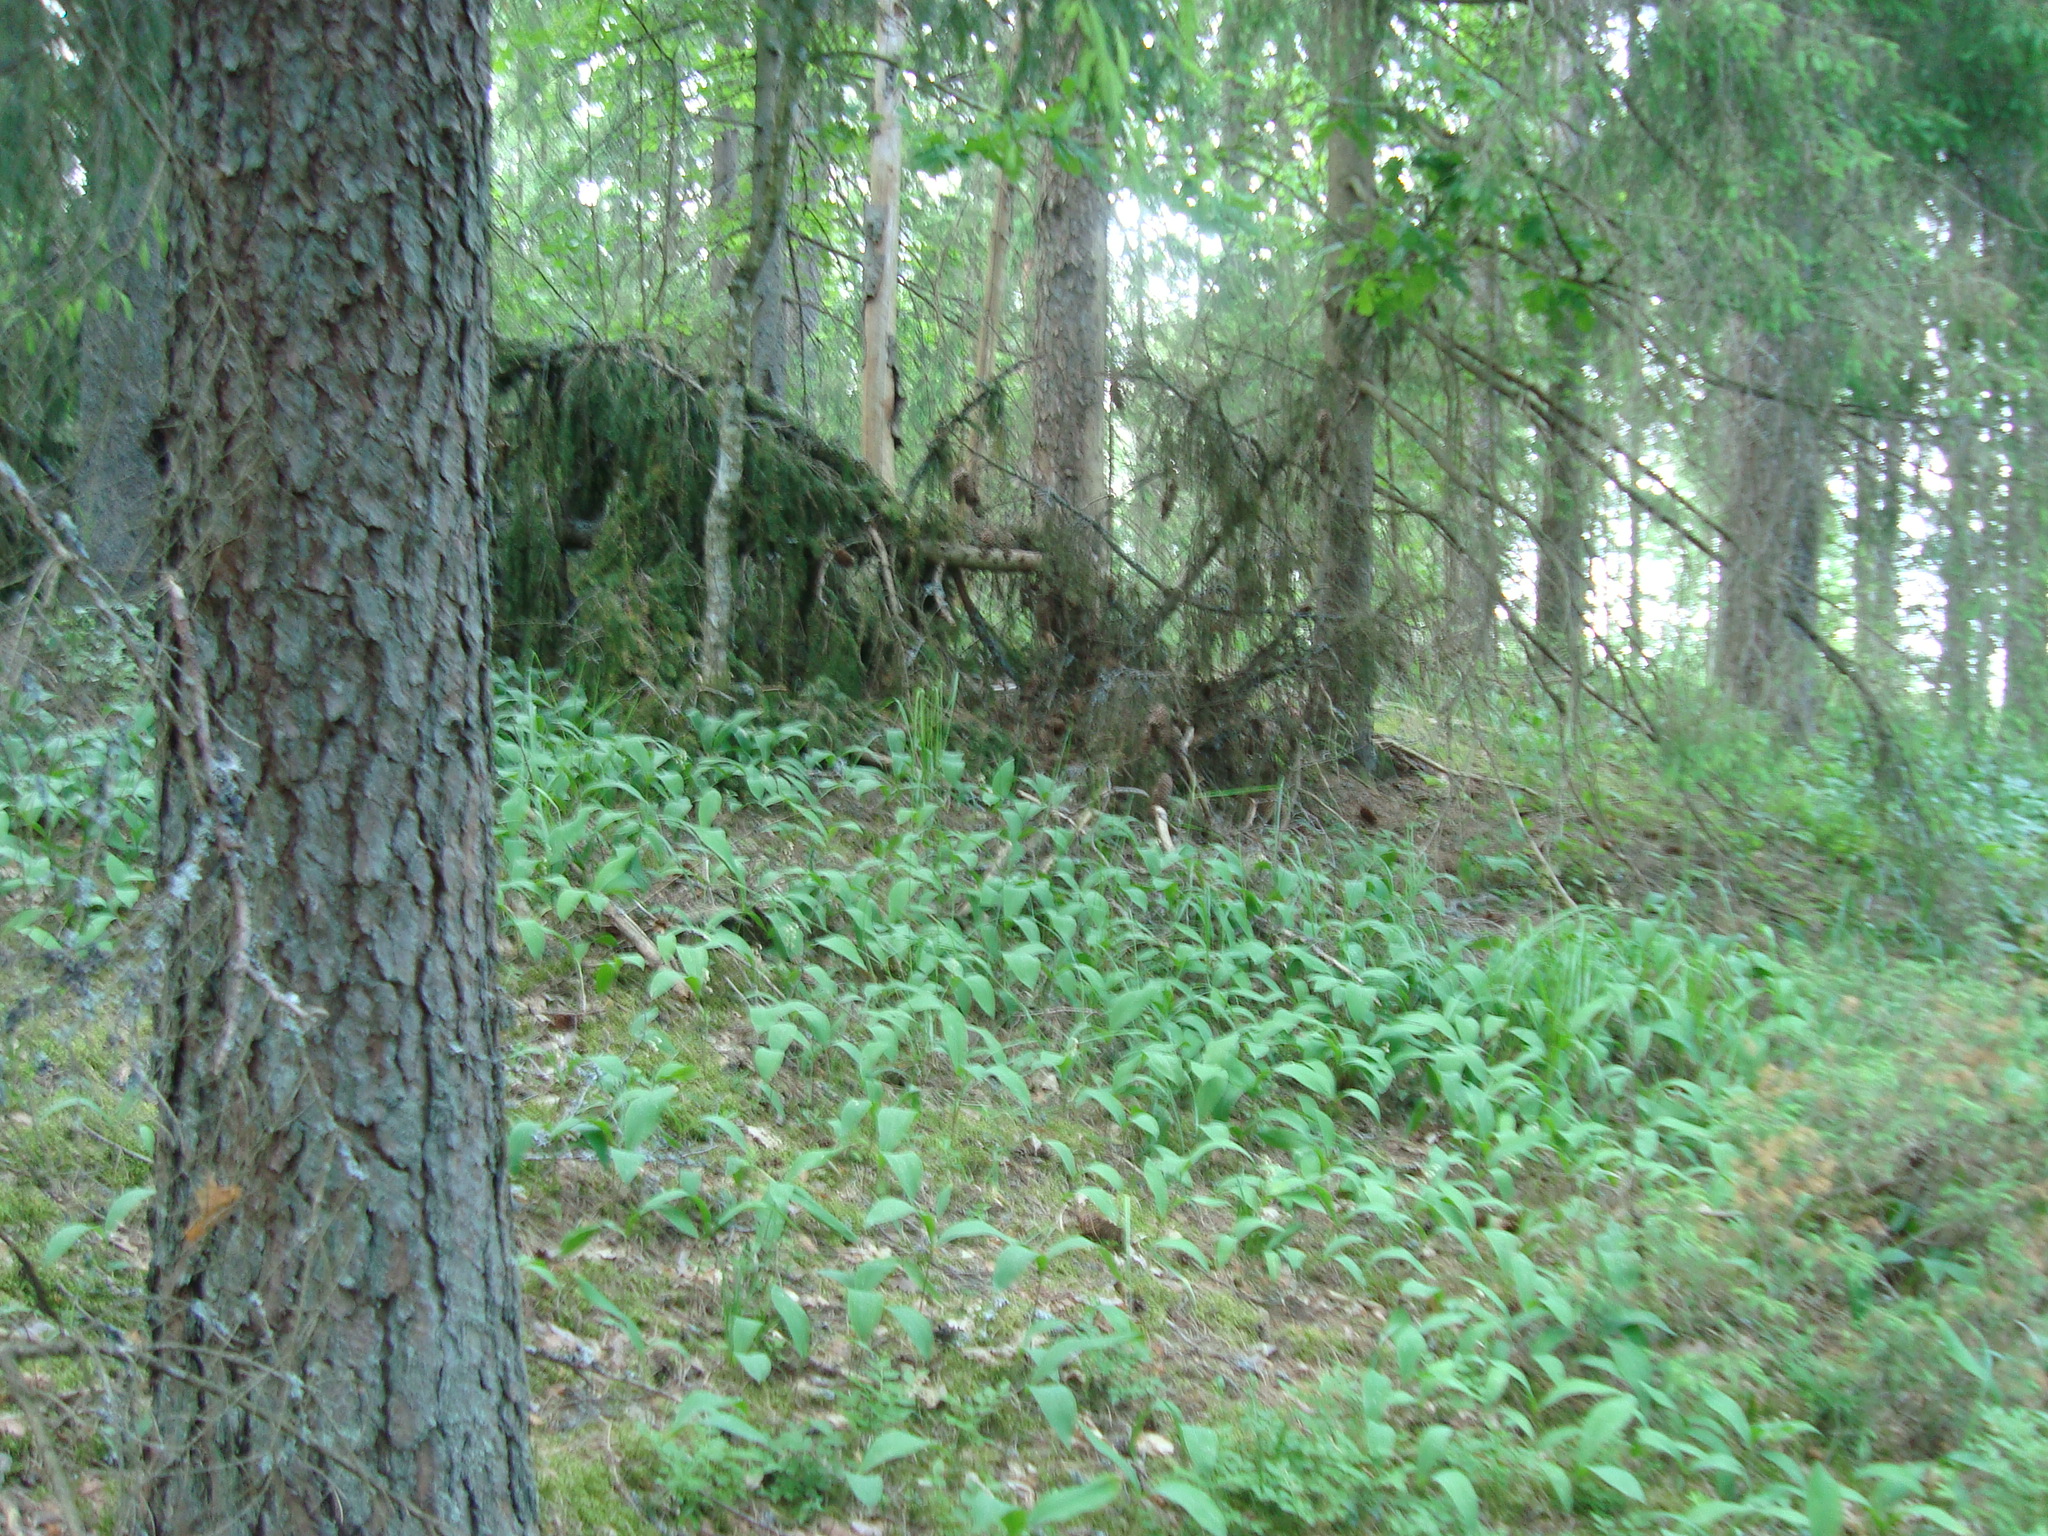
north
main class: Woodland
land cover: Spruce dominated coniferous woodland
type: hemiboreal forest and nemoral coniferous forest and mixed broadleaved-coniferous forest
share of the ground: > 75 %
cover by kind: coniferous forest trees 80 %, herbaceous plants 10 %, broadleaved forest trees 5 %, lichens and mosses 5 %
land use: Forestry
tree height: > 5 m
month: June
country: LV
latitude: 56.6934
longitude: 25.7523
